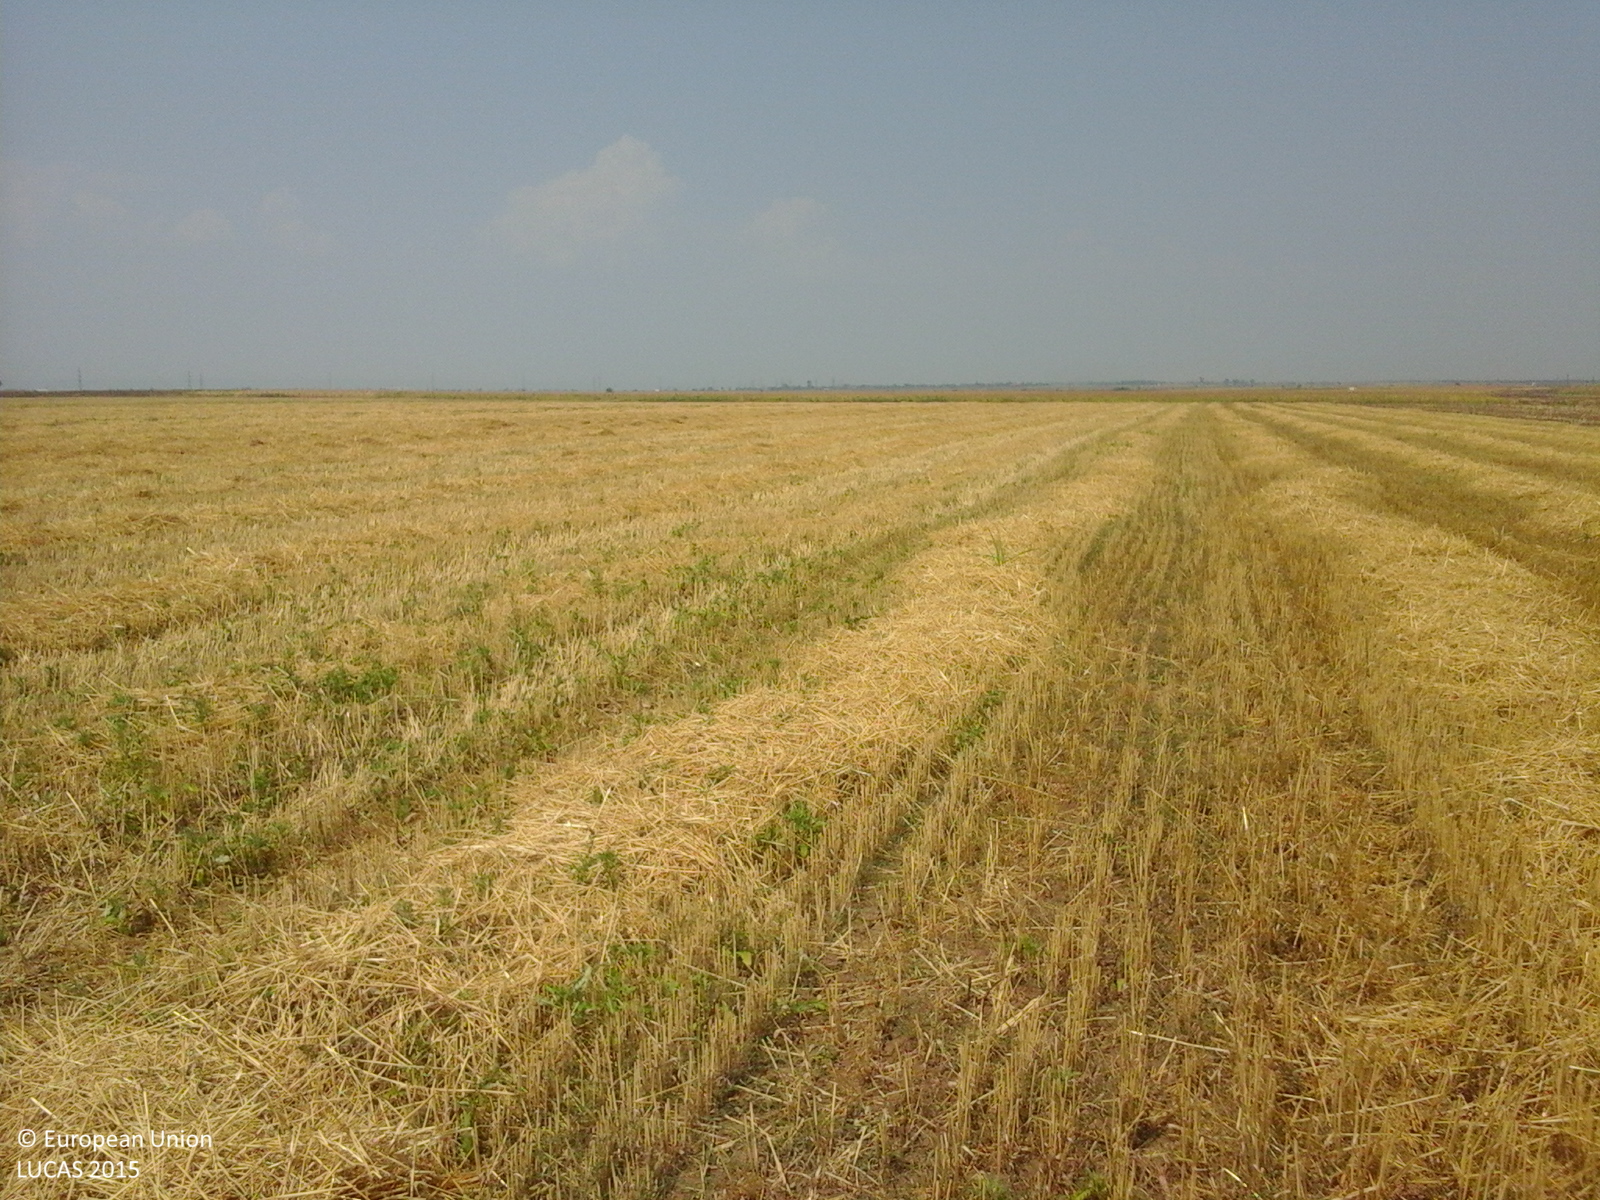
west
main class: Cropland
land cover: Common wheat
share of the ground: > 75 %
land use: Agriculture (excluding fallow land and kitchen gardens)
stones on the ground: < 10 %
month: August
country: RO
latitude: 44.2356
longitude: 22.7481
